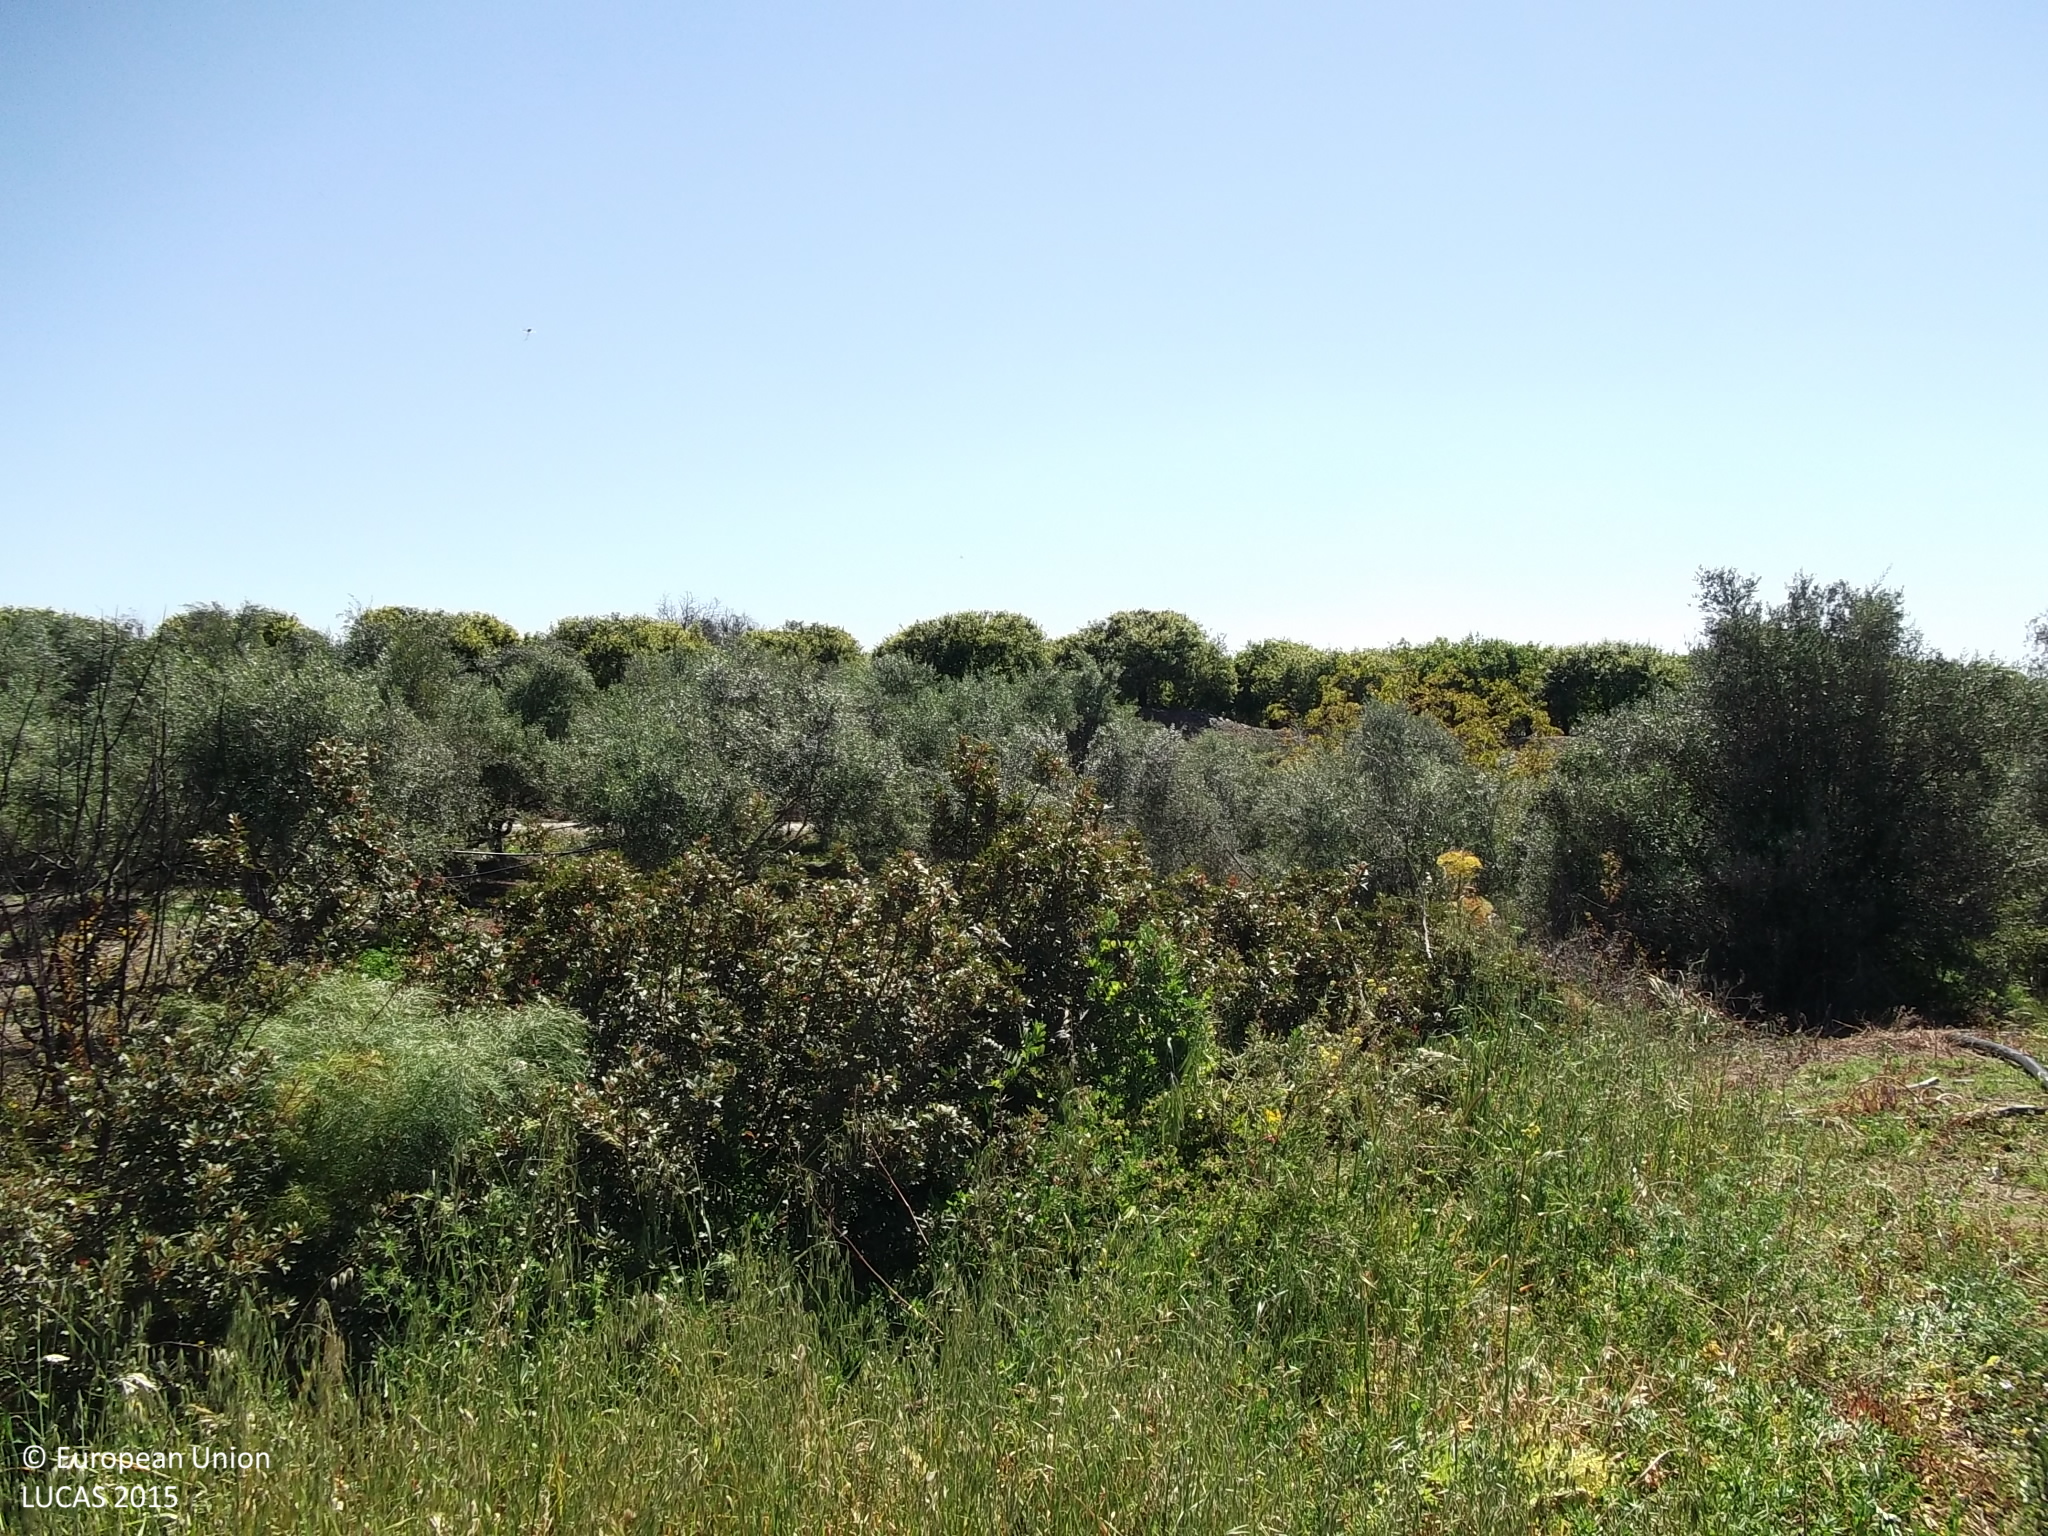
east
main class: Grassland
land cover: Spontaneously vegetated surfaces
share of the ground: > 75 %
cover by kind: herbaceous plants 100 %
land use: Fallow land
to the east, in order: Spontaneously vegetated surfaces; Broadleaved woodland; Inland fresh running water; Olive groves; Paved roads, cycling and walking lanes; Other citrus fruit; Other bare soil; Single bushes/trees; Other bare soil; Single bushes/trees; Other bare soil; Single bushes/trees; Other bare soil; Other citrus fruit; Oranges; Tracks; Spontaneously vegetated surfaces
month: April
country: CY
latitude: 34.8432
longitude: 33.1737
